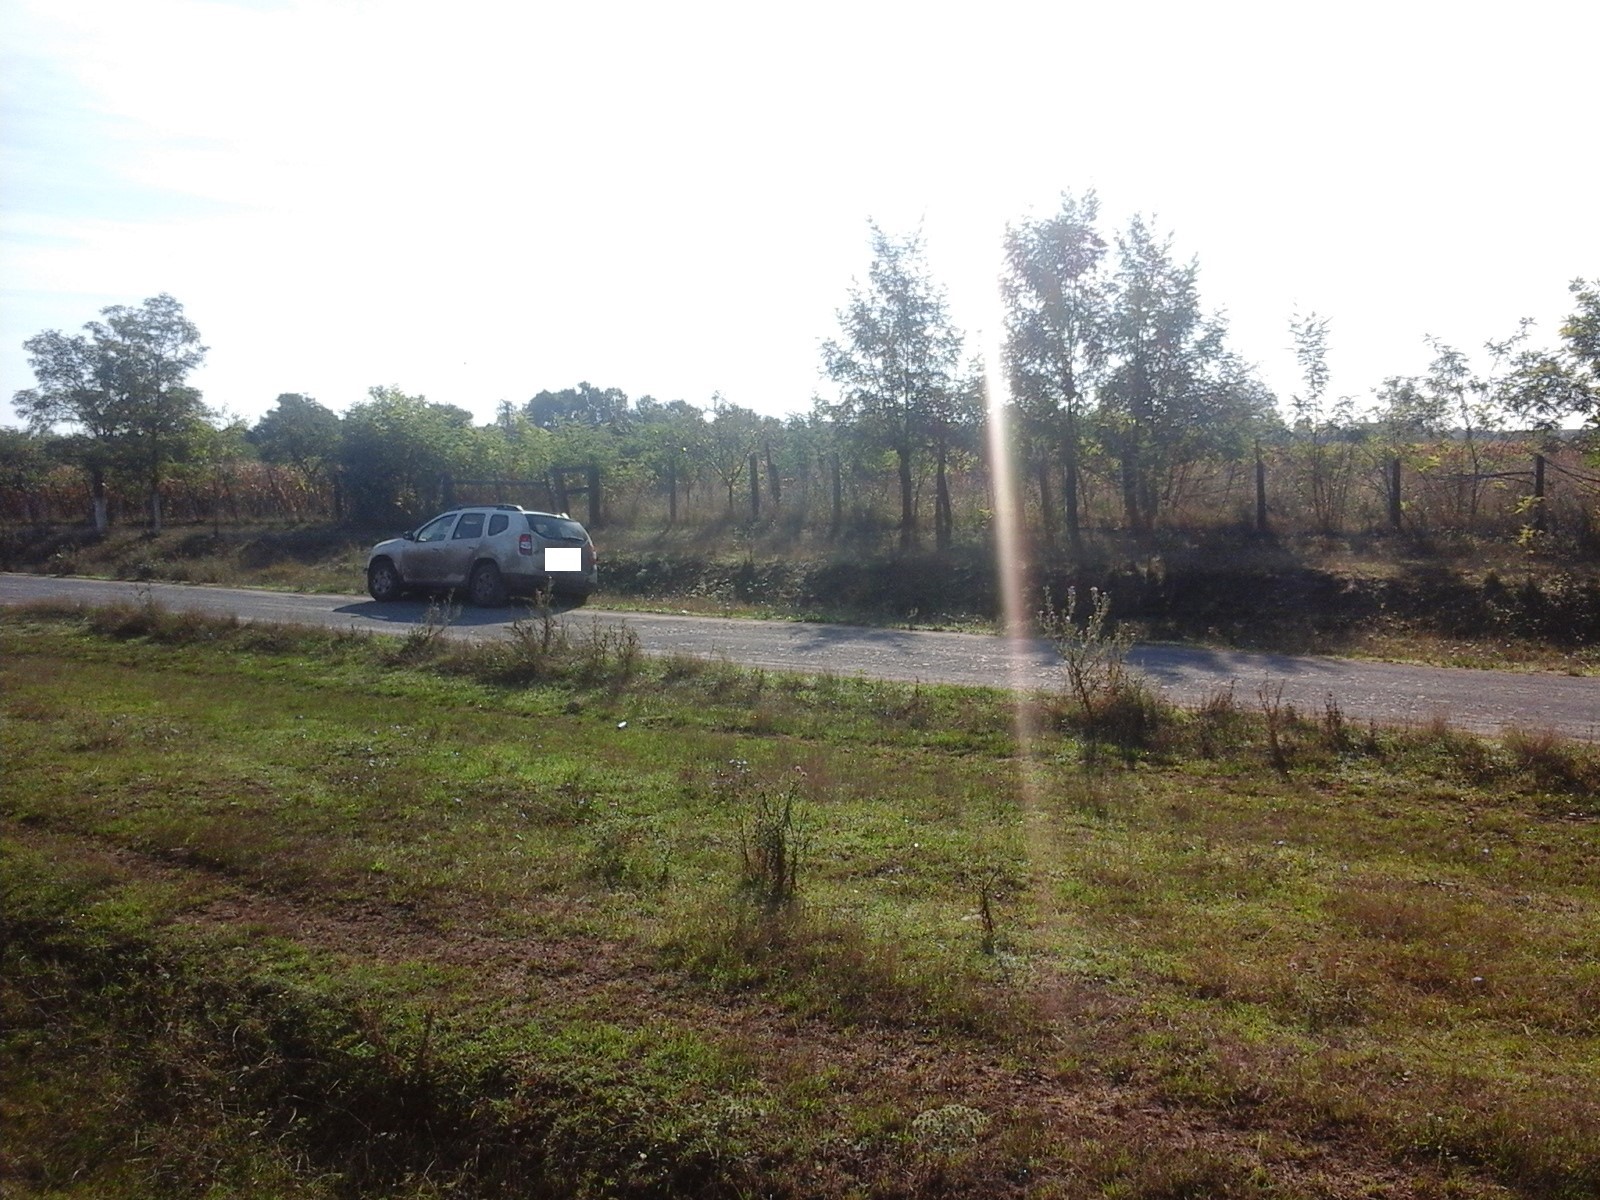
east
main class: Grassland
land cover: Grassland without tree/shrub cover
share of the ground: > 75 %
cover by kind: herbaceous plants 100 %
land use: Residential
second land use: Agriculture (excluding fallow land and kitchen gardens)
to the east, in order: Fences; Grassland without tree/shrub cover; Electric lines; Grassland without tree/shrub cover; Paved roads, cycling and walking lanes; Grassland without tree/shrub cover; Fences; Maize; Fences; Maize; Fences; Arable land (only in case pi); Fences; Arable land (only in case pi); Artificial constructions in urban areas
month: August
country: RO
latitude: 46.0054
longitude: 21.1236
